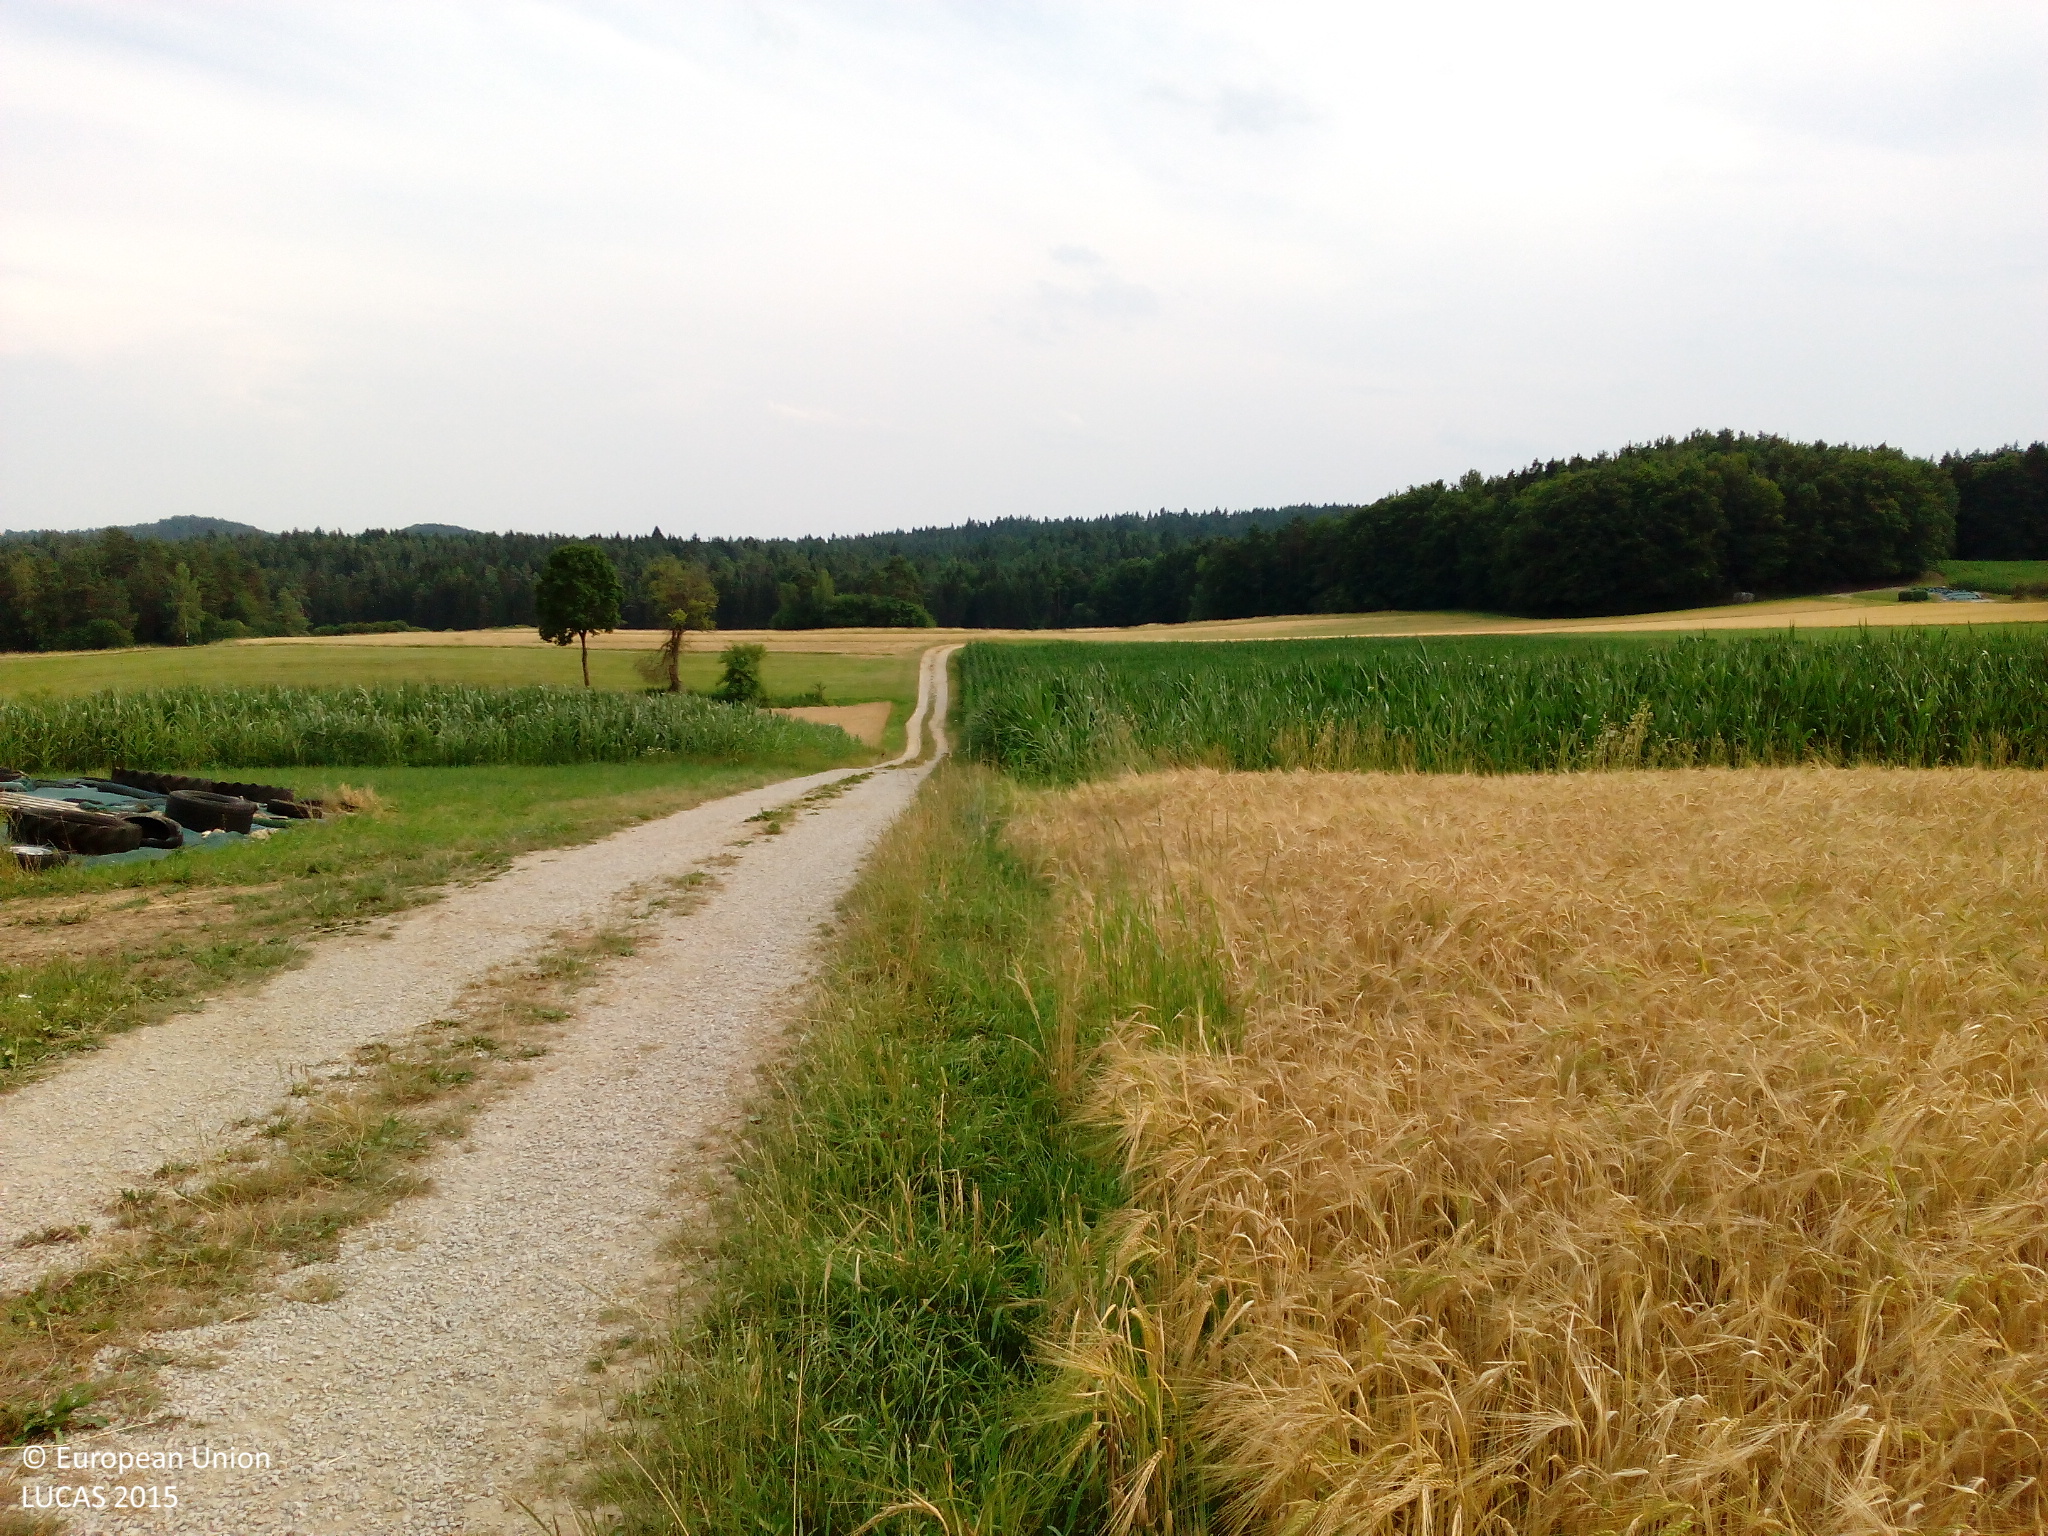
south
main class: Cropland
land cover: Barley
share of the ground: > 75 %
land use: Agriculture (excluding fallow land and kitchen gardens)
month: July
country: DE
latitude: 49.6350
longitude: 11.4811
